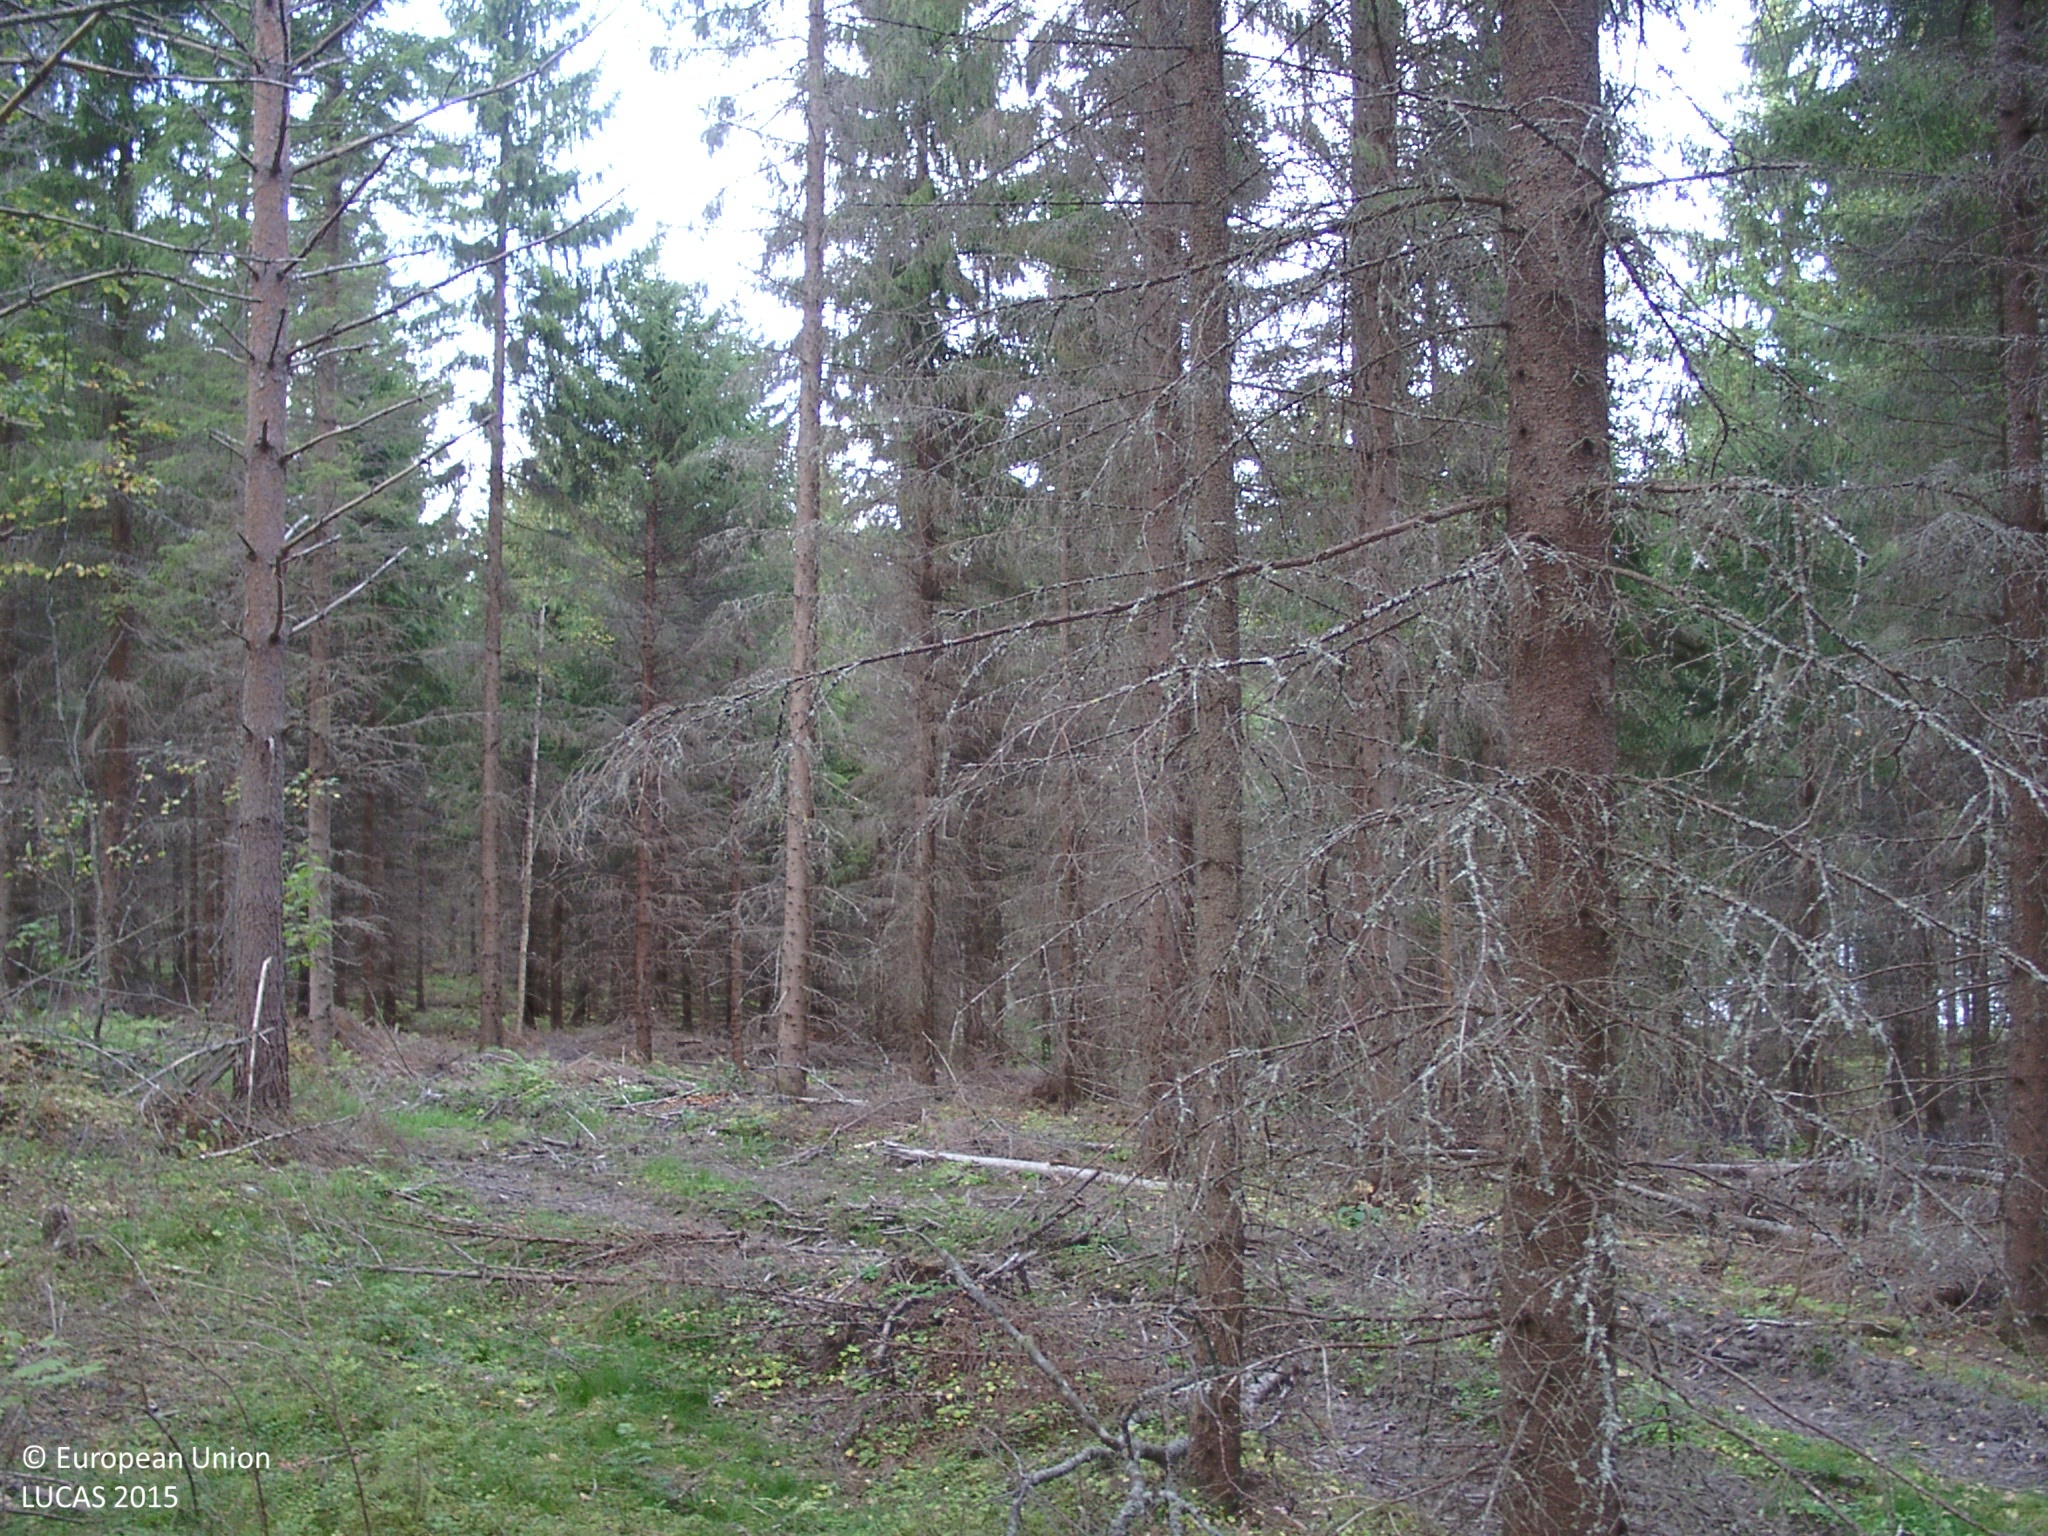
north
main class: Woodland
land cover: Spruce dominated coniferous woodland
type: boreal forest
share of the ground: > 75 %
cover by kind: coniferous forest trees 75 %, unconsolidated bare surface 15 %, lichens and mosses 10 %
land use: Forestry
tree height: > 5 m
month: September
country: FI
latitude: 62.5566
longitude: 25.6949
